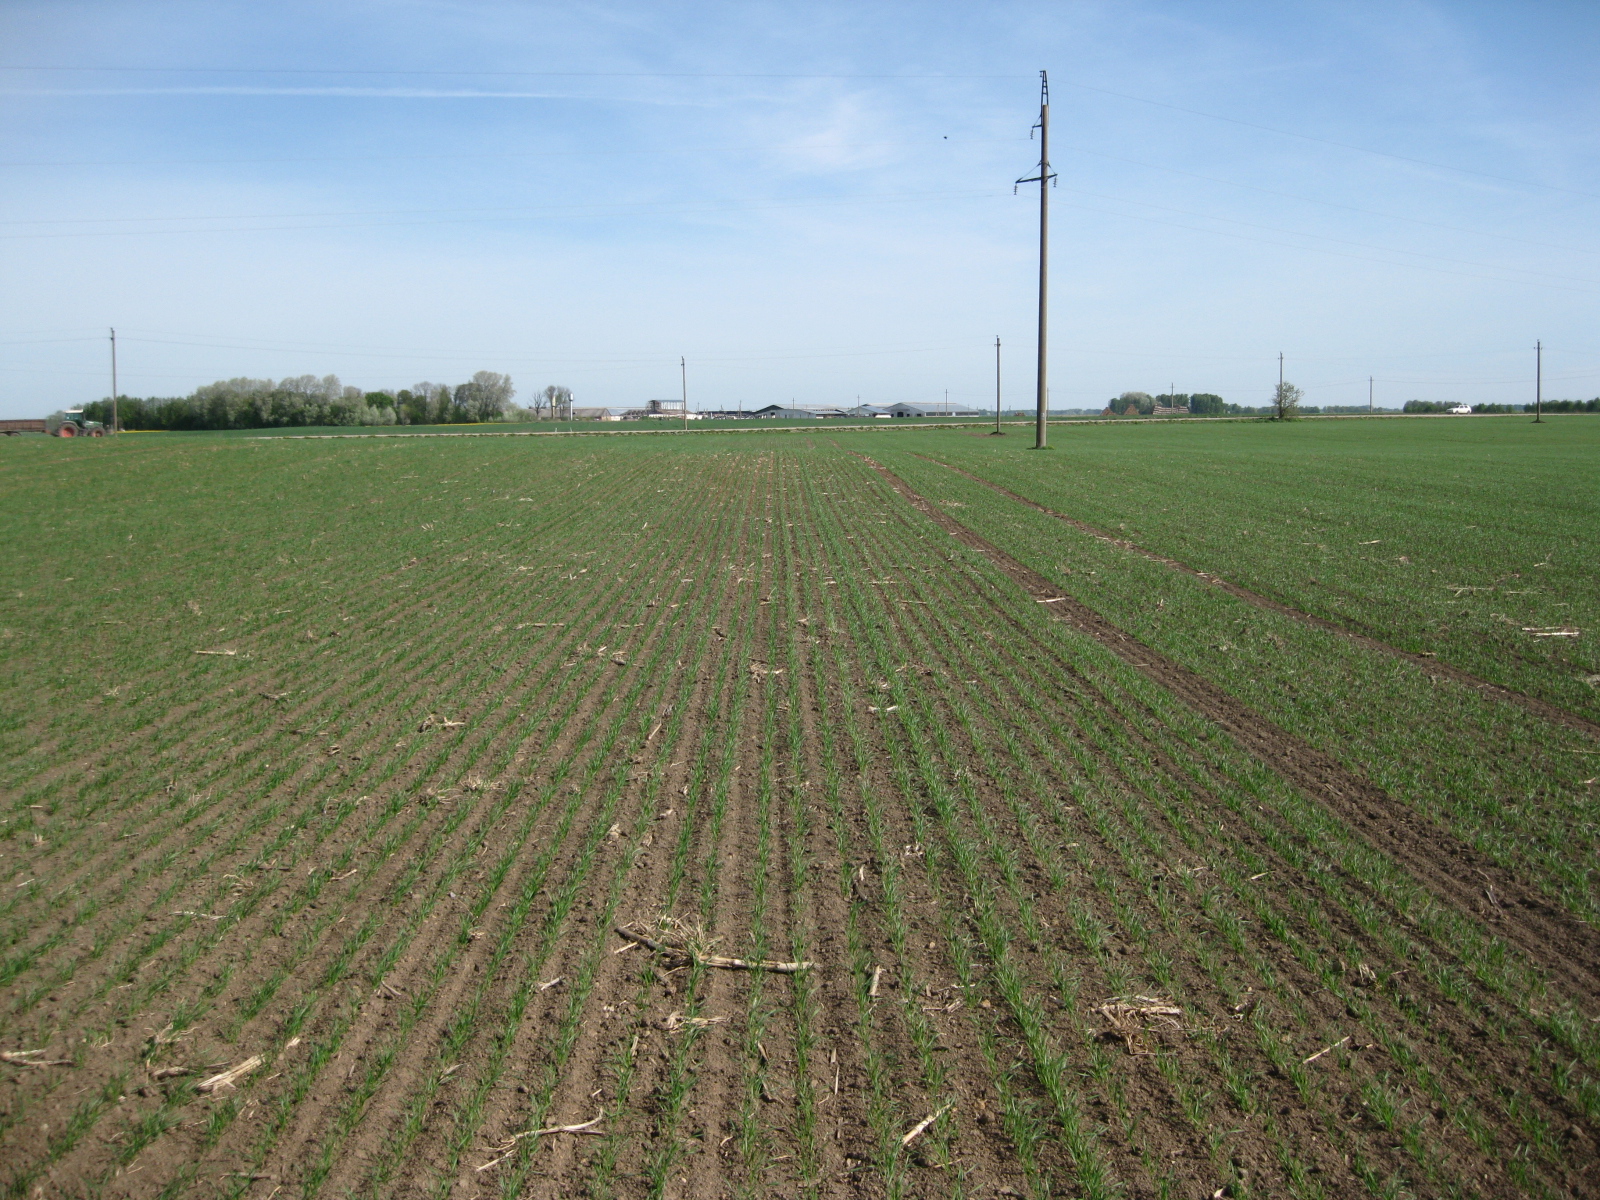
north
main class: Cropland
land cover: Common wheat
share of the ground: < 10 %
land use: Agriculture (excluding fallow land and kitchen gardens)
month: May
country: LT
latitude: 56.1769
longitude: 24.2183
